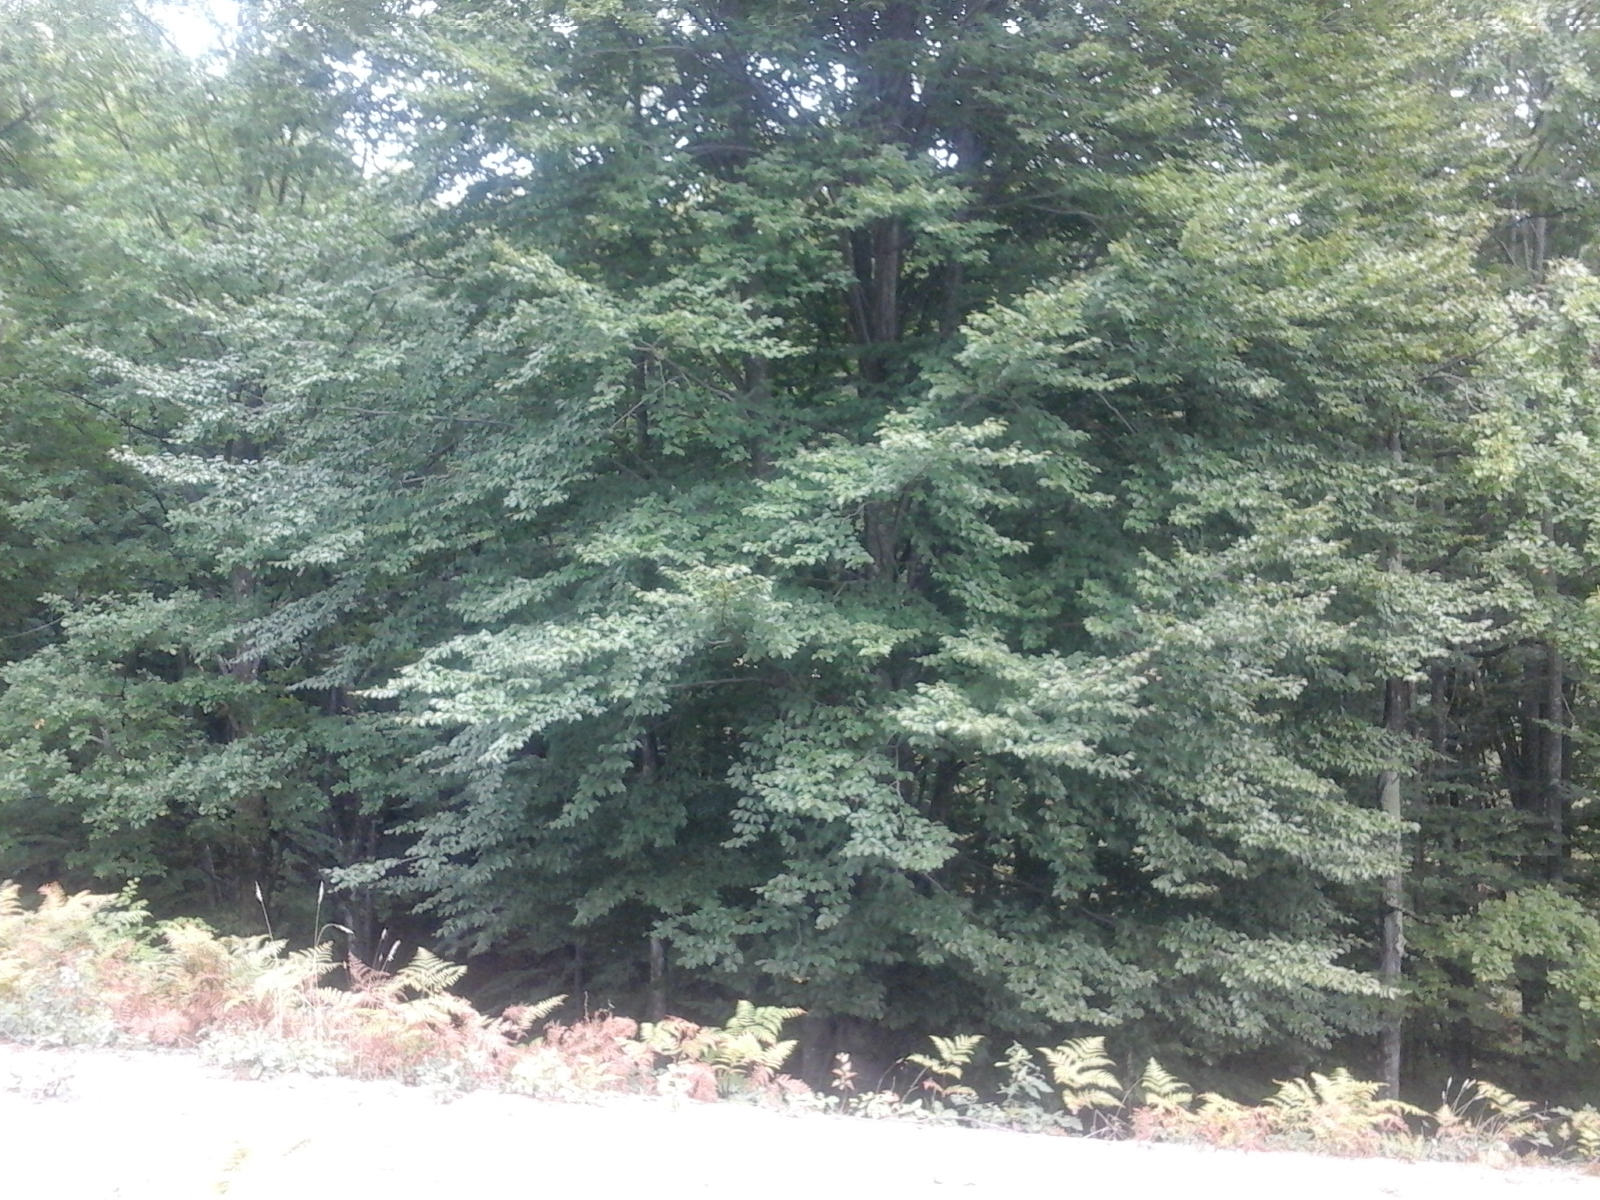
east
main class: Woodland
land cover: Broadleaved woodland
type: beech forest
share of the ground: > 75 %
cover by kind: broadleaved forest trees 100 %
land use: Forestry
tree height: > 5 m
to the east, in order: Broadleaved woodland; Tracks; Broadleaved woodland; Arable land (only in case pi); Abandoned hedges; Arable land (only in case pi); Abandoned hedges
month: September
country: RO
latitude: 45.0459
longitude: 22.8320
